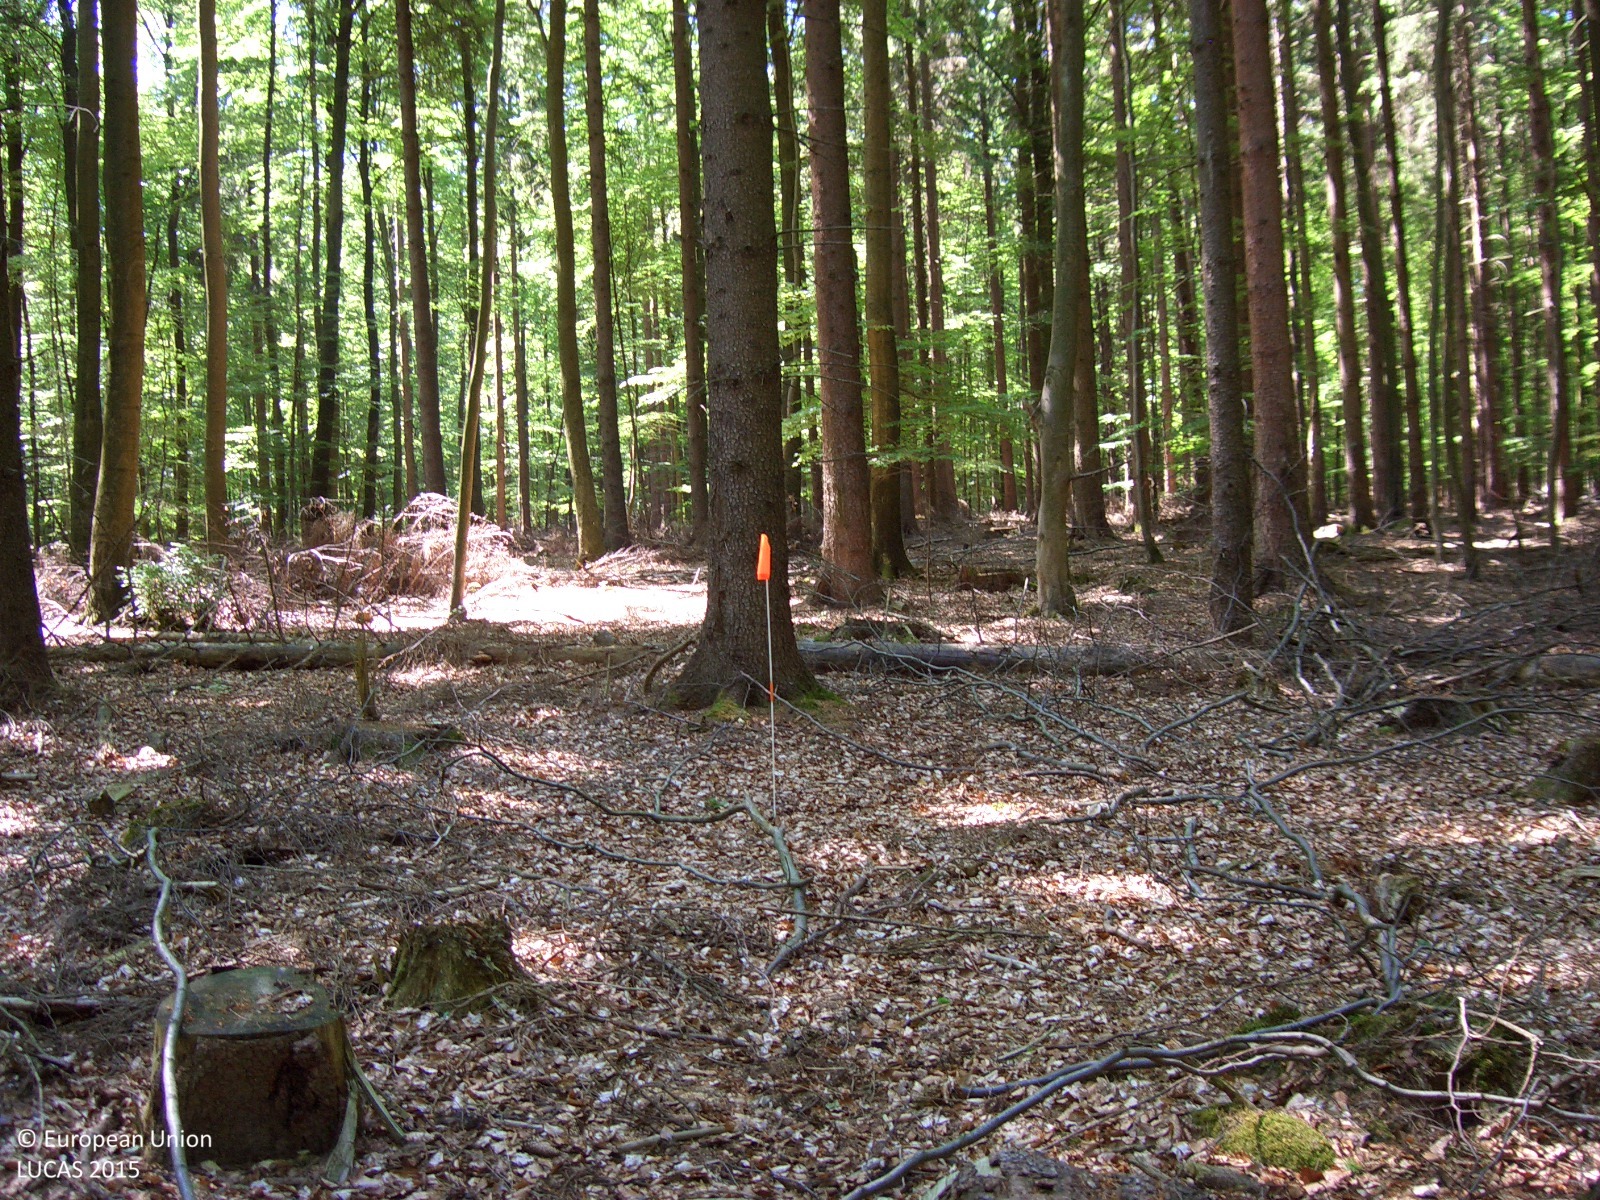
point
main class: Woodland
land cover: Spruce dominated mixed woodland
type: beech forest
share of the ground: > 75 %
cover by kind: broadleaved forest trees 70 %, coniferous forest trees 30 %
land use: Forestry
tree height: > 5 m
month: June
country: DE
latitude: 50.6985
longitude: 6.2475
